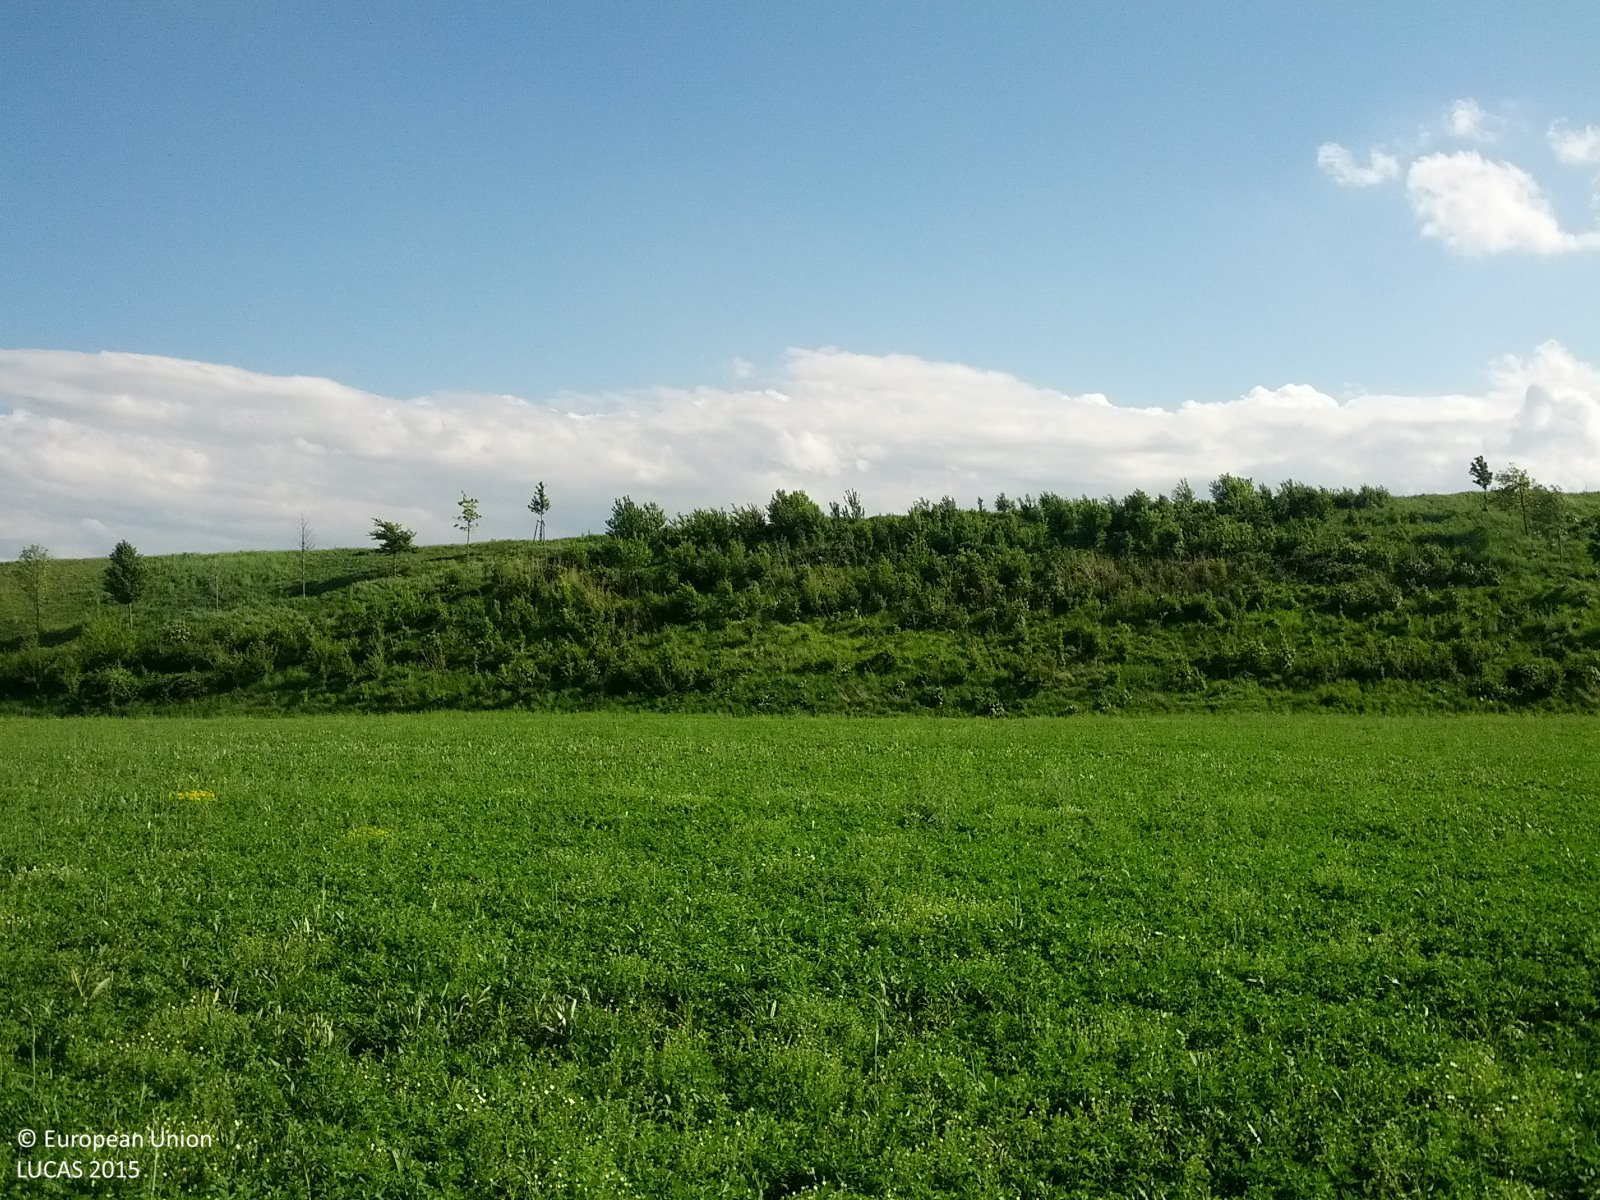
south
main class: Cropland
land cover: Lucerne
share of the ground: 50 - 75 %
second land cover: Other leguminous and mixtures for fodder
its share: 50 - 75 %
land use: Agriculture (excluding fallow land and kitchen gardens)
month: May
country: AT
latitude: 48.1254
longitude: 16.4405
